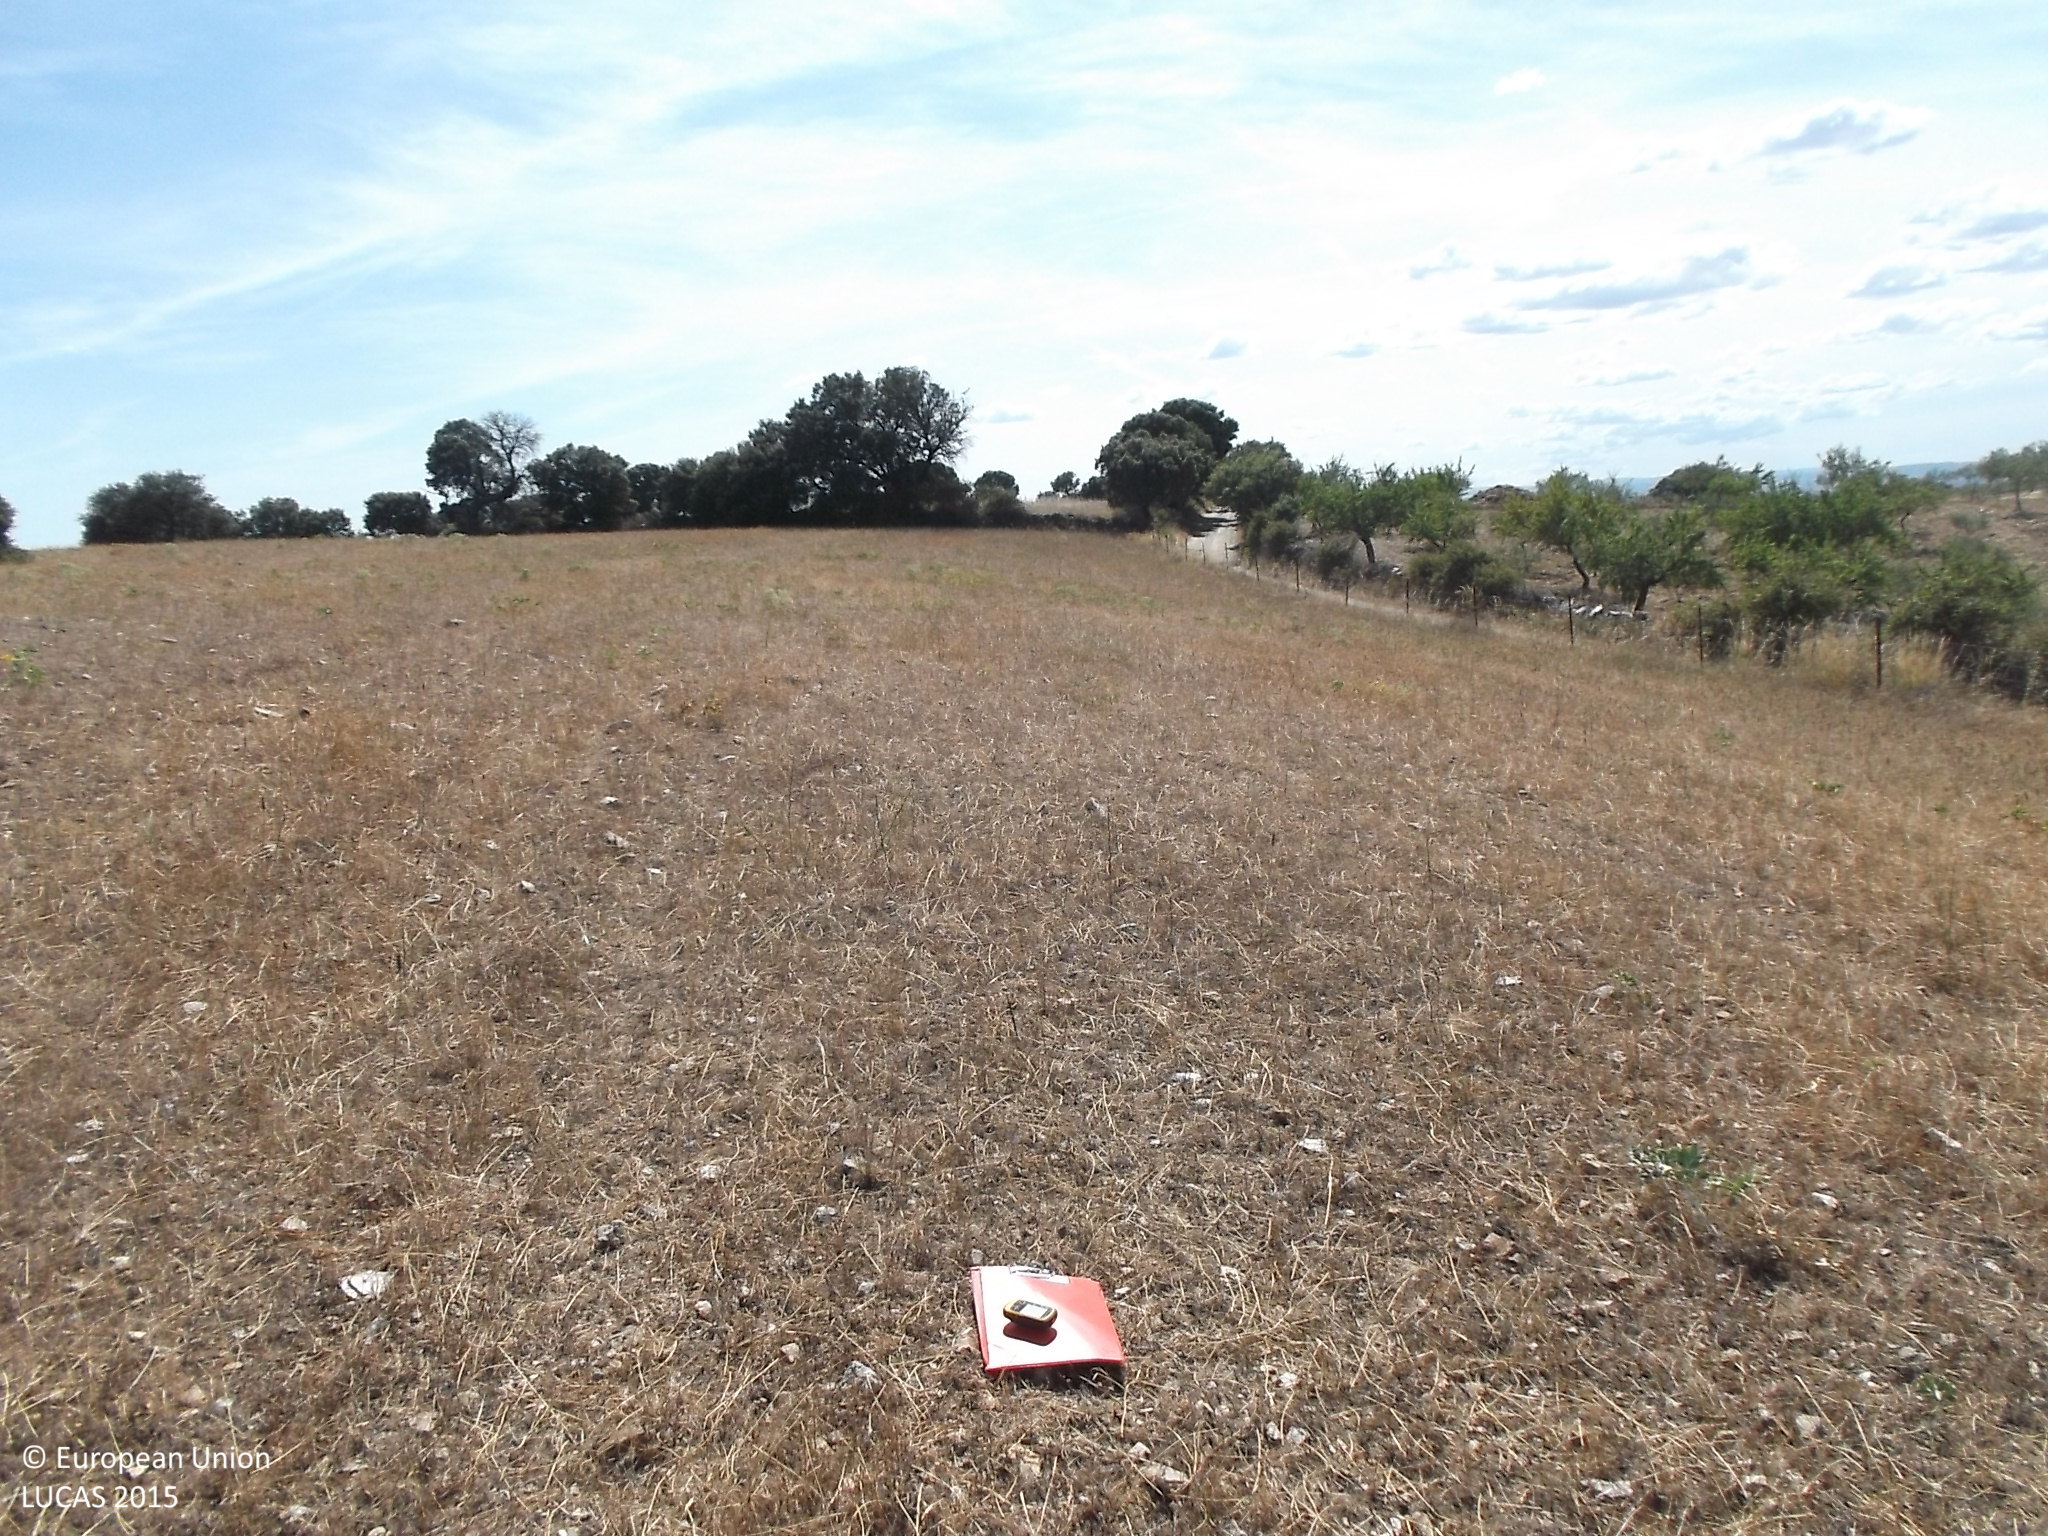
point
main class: Grassland
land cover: Grassland without tree/shrub cover
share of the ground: > 75 %
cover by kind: herbaceous plants 95 %, shrubs 5 %
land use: Agriculture (excluding fallow land and kitchen gardens)
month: July
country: ES
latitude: 40.9907
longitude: -6.8517
